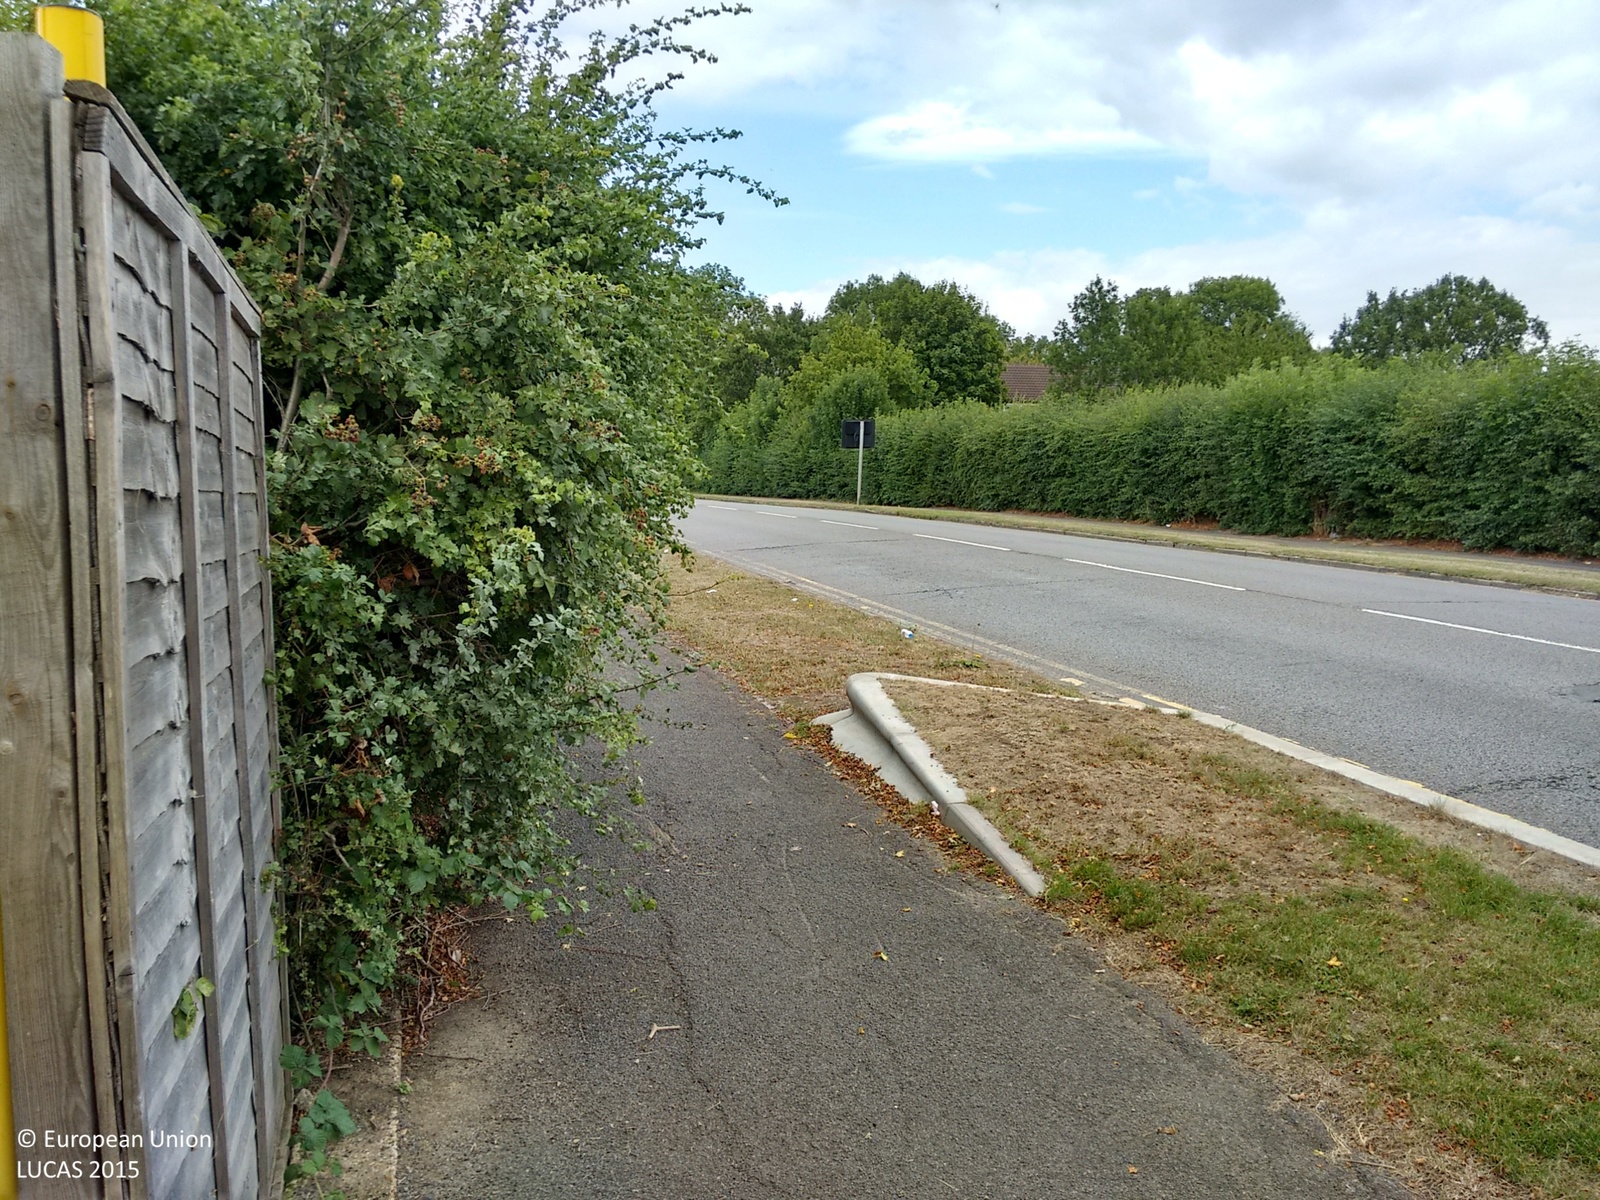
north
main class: Grassland
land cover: Grassland without tree/shrub cover
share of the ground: > 75 %
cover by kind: herbaceous plants 100 %
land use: Air transport
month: July
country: GB
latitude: 51.5561
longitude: -0.4076
